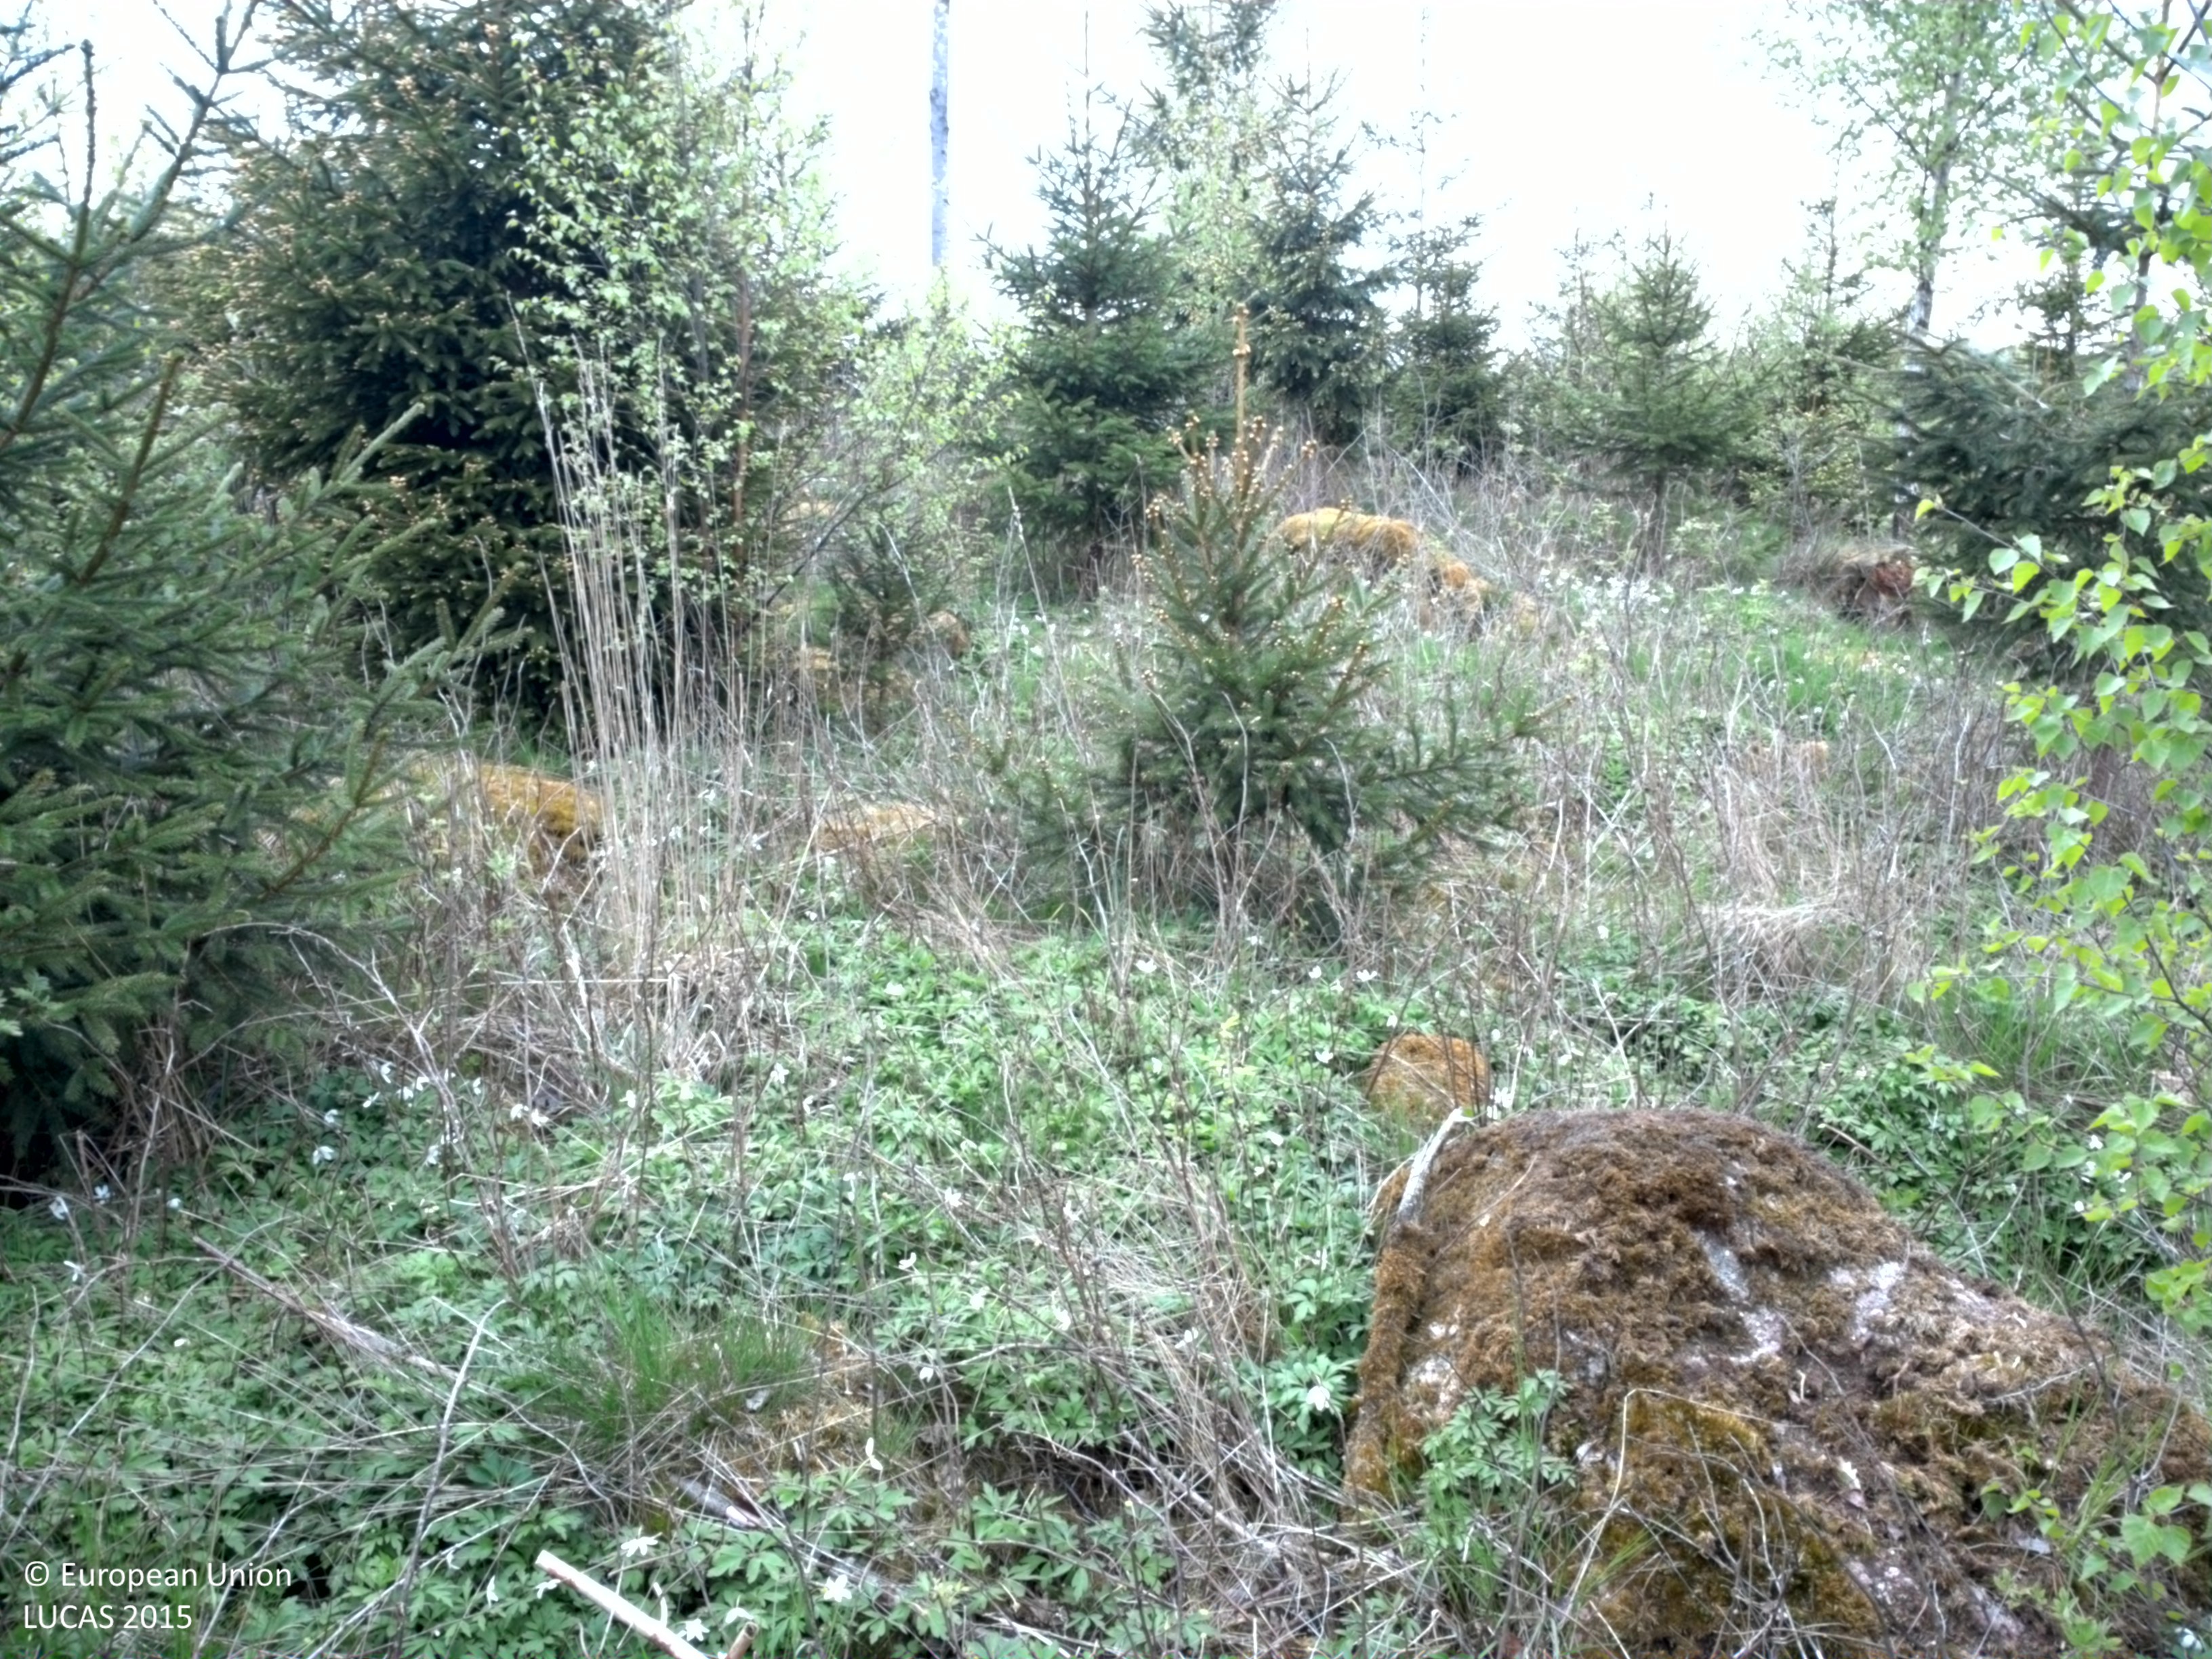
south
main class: Woodland
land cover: Spruce dominated mixed woodland
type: boreal forest
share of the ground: > 75 %
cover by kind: coniferous forest trees 55 %, broadleaved forest trees 20 %, herbaceous plants 20 %, shrubs 5 %
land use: Forestry
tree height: < 5 m
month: May
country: SE
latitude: 56.4140
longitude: 15.4614
